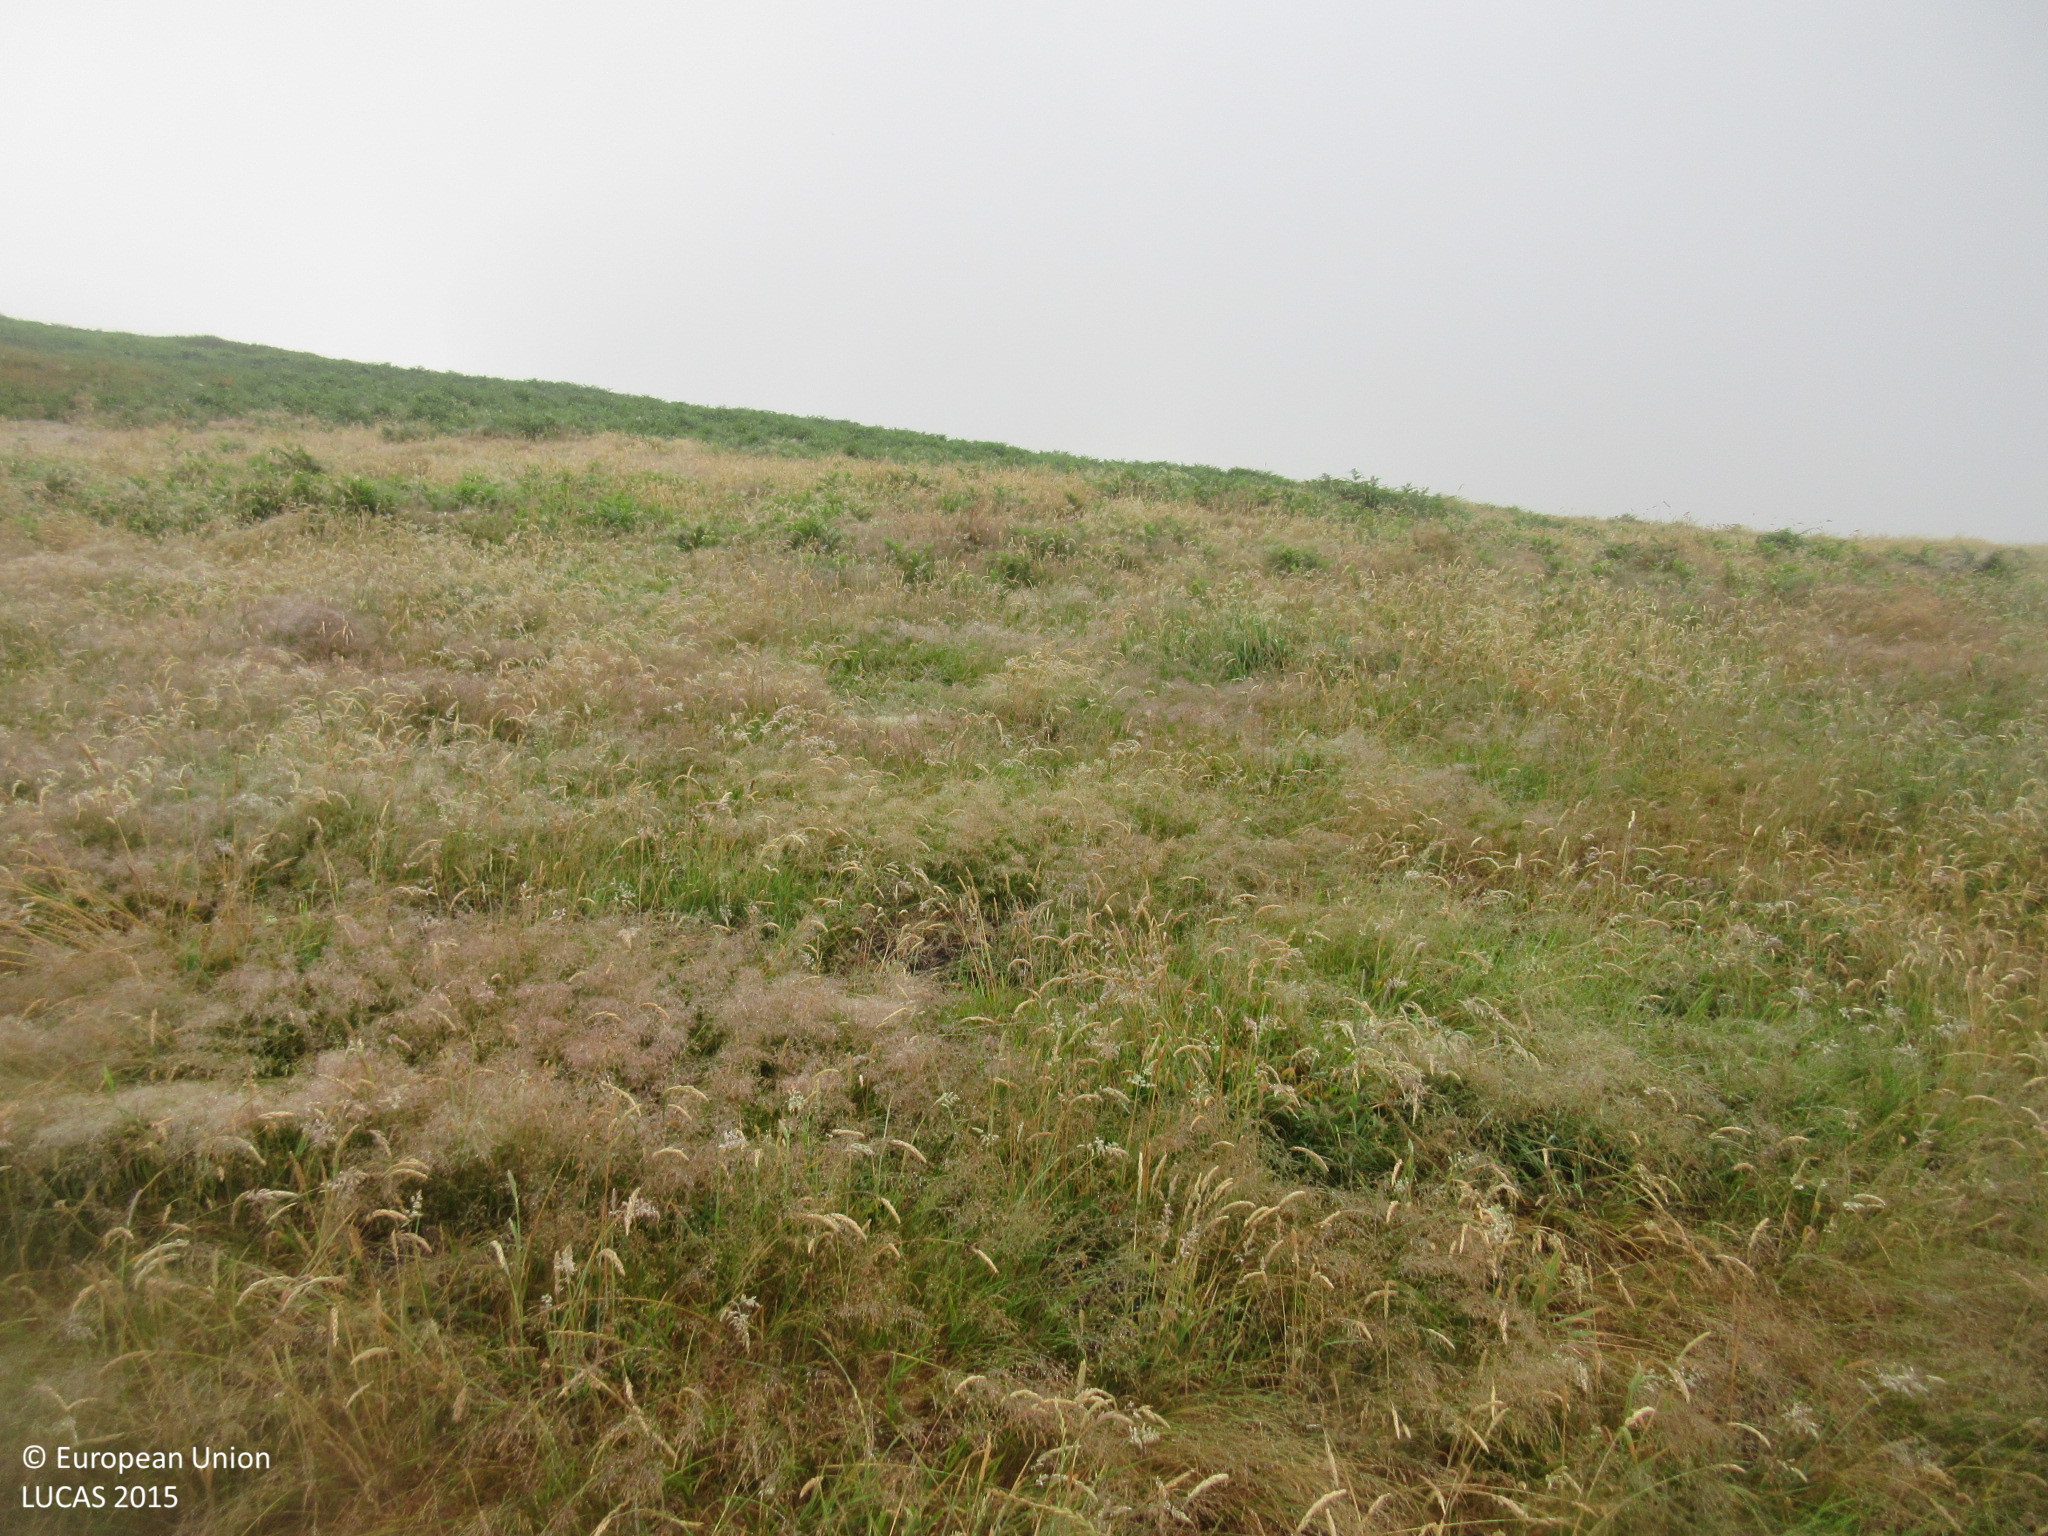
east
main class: Grassland
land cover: Grassland without tree/shrub cover
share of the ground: > 75 %
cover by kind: herbaceous plants 100 %
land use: Agriculture (excluding fallow land and kitchen gardens)
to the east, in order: Grassland without tree/shrub cover; Shrubland without tree cover; Rocks and stones
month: July
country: ES
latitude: 43.3245
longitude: -6.3144
